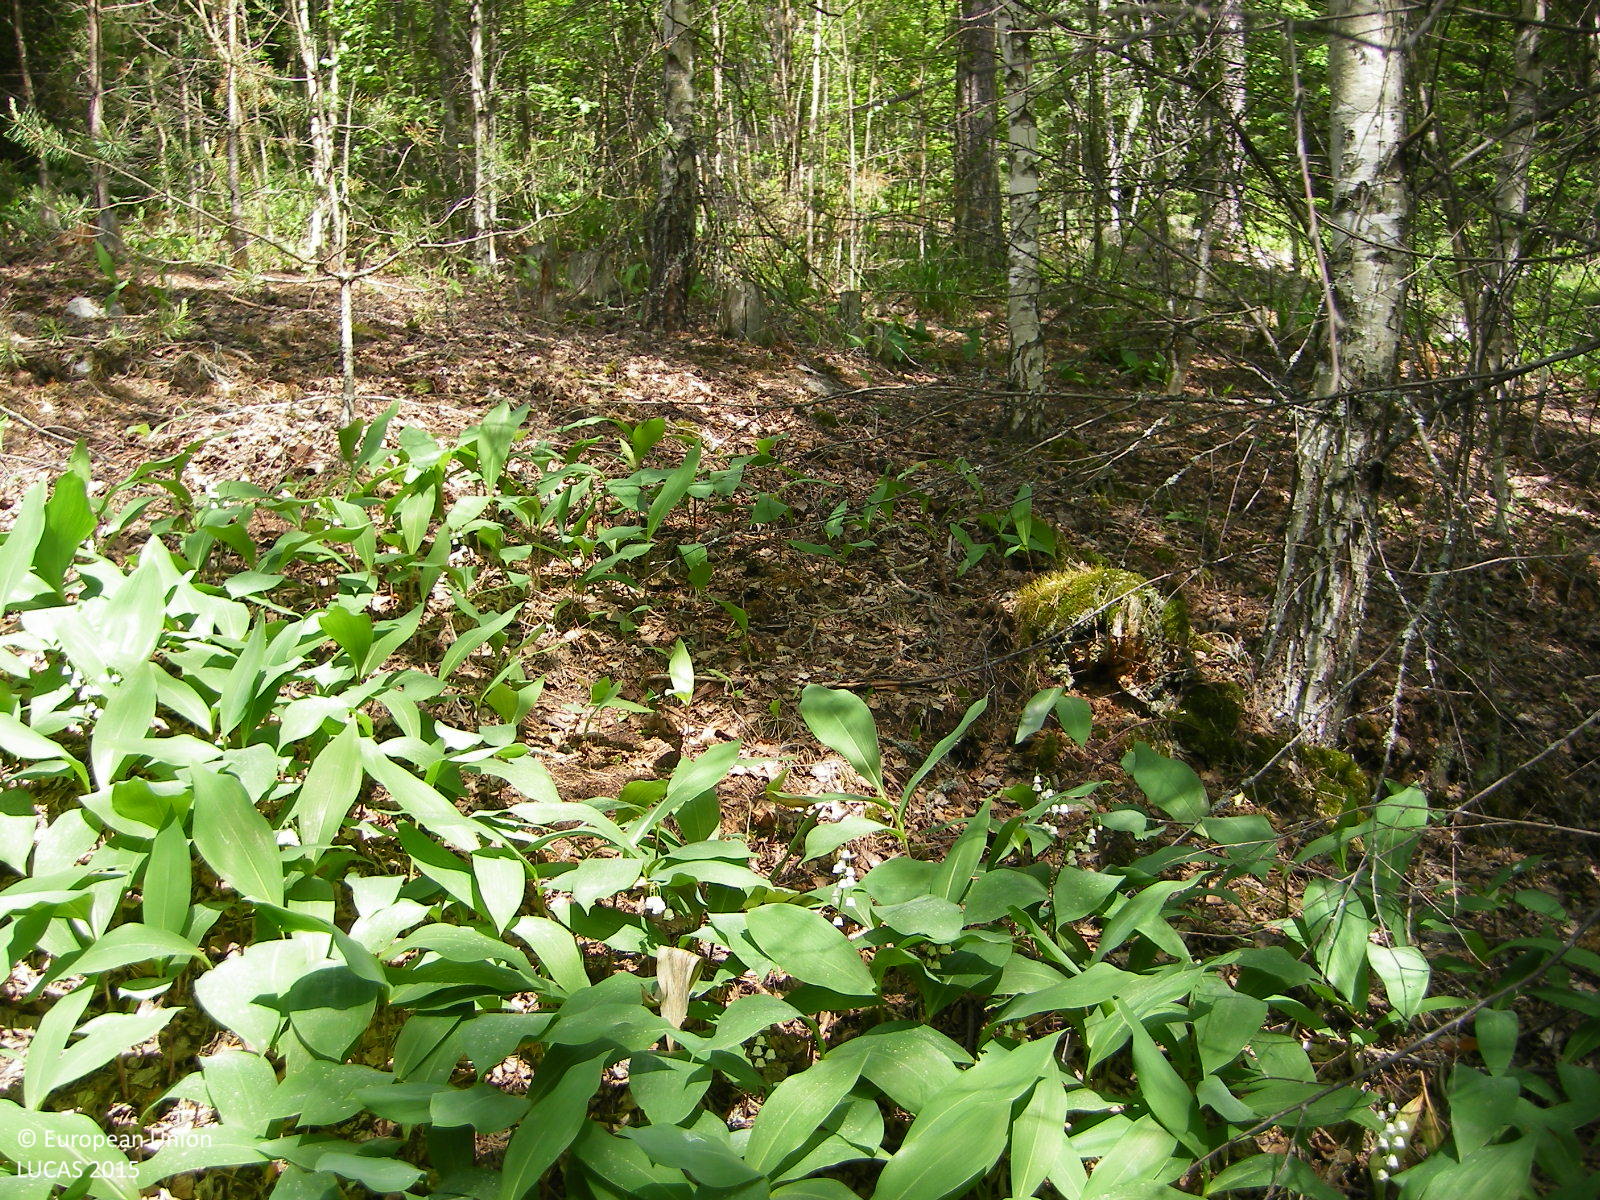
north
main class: Woodland
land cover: Broadleaved woodland
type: boreal forest
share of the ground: > 75 %
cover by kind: broadleaved forest trees 70 %, herbaceous plants 20 %, coniferous forest trees 5 %, lichens and mosses 5 %
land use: Forestry
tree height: > 5 m
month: June
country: FI
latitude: 60.4306
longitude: 24.3649
